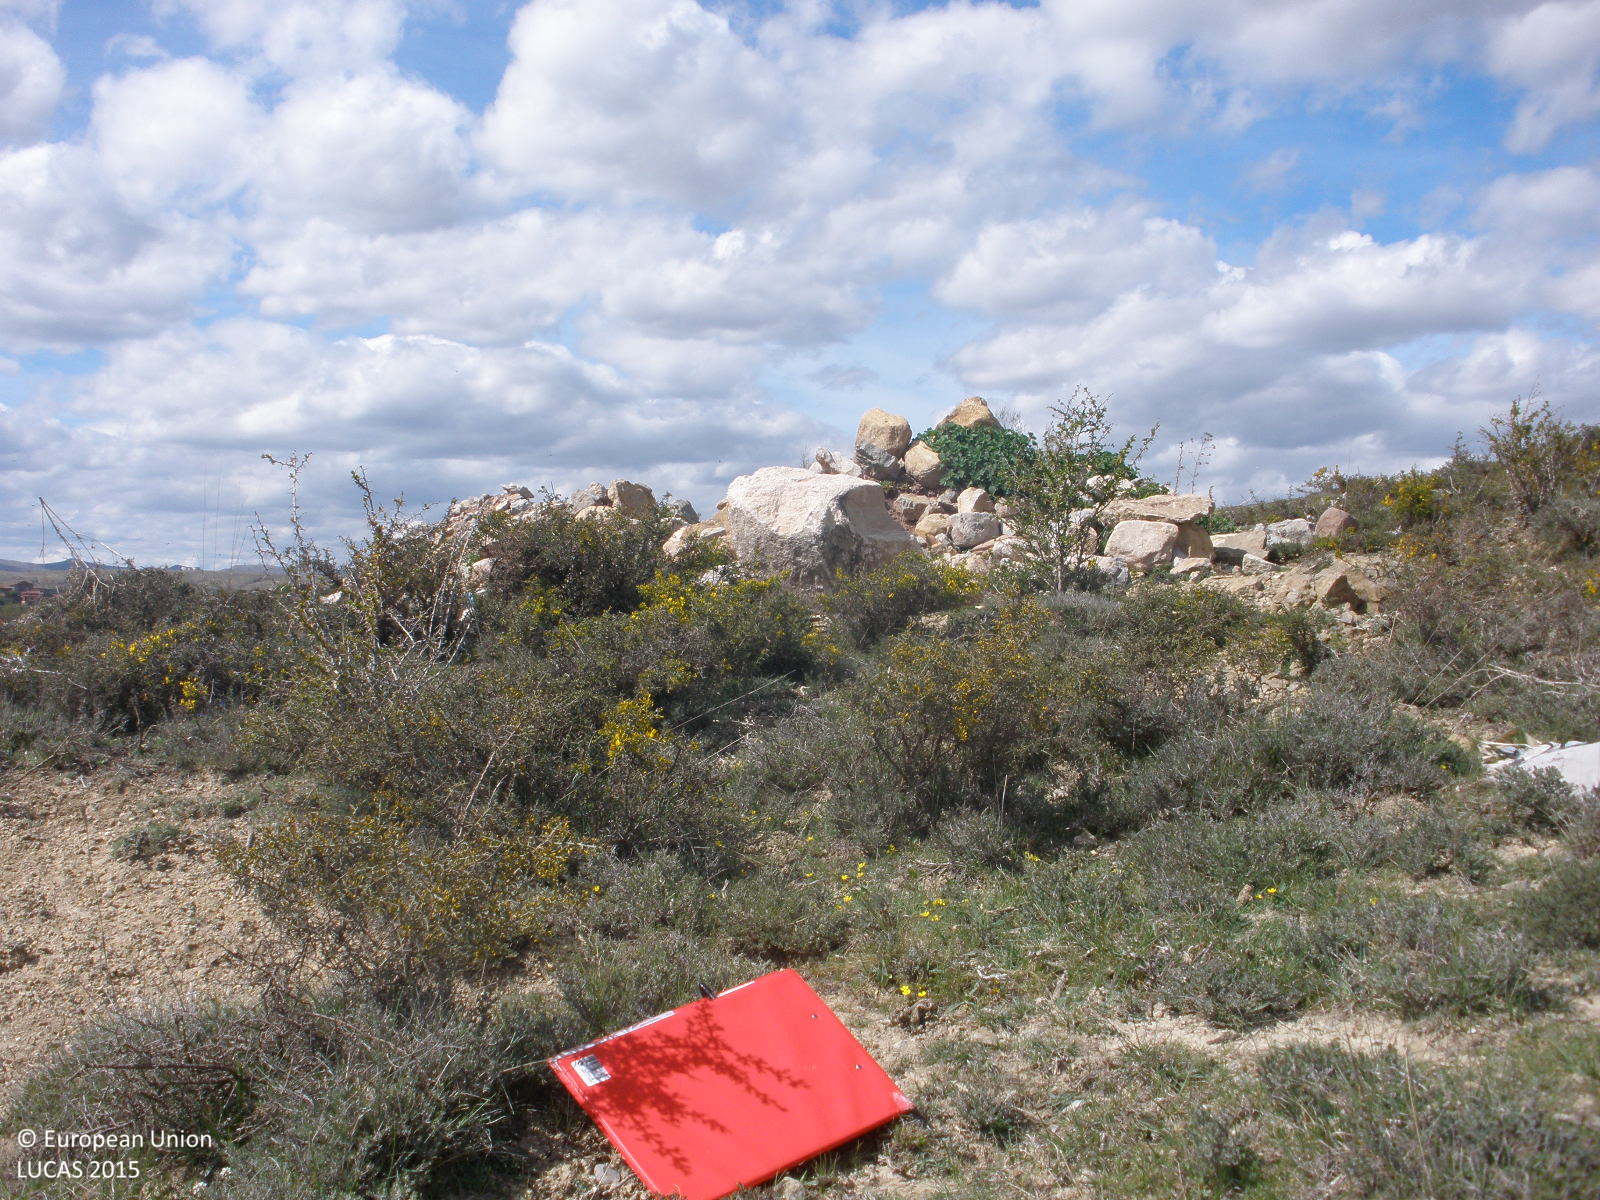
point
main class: Shrubland
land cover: Shrubland without tree cover
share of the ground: 50 - 75 %
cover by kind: shrubs 50 %, consolidated bare surface 30 %, herbaceous plants 20 %
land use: Agriculture (excluding fallow land and kitchen gardens)
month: April
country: ES
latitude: 40.4305
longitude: -0.8426
